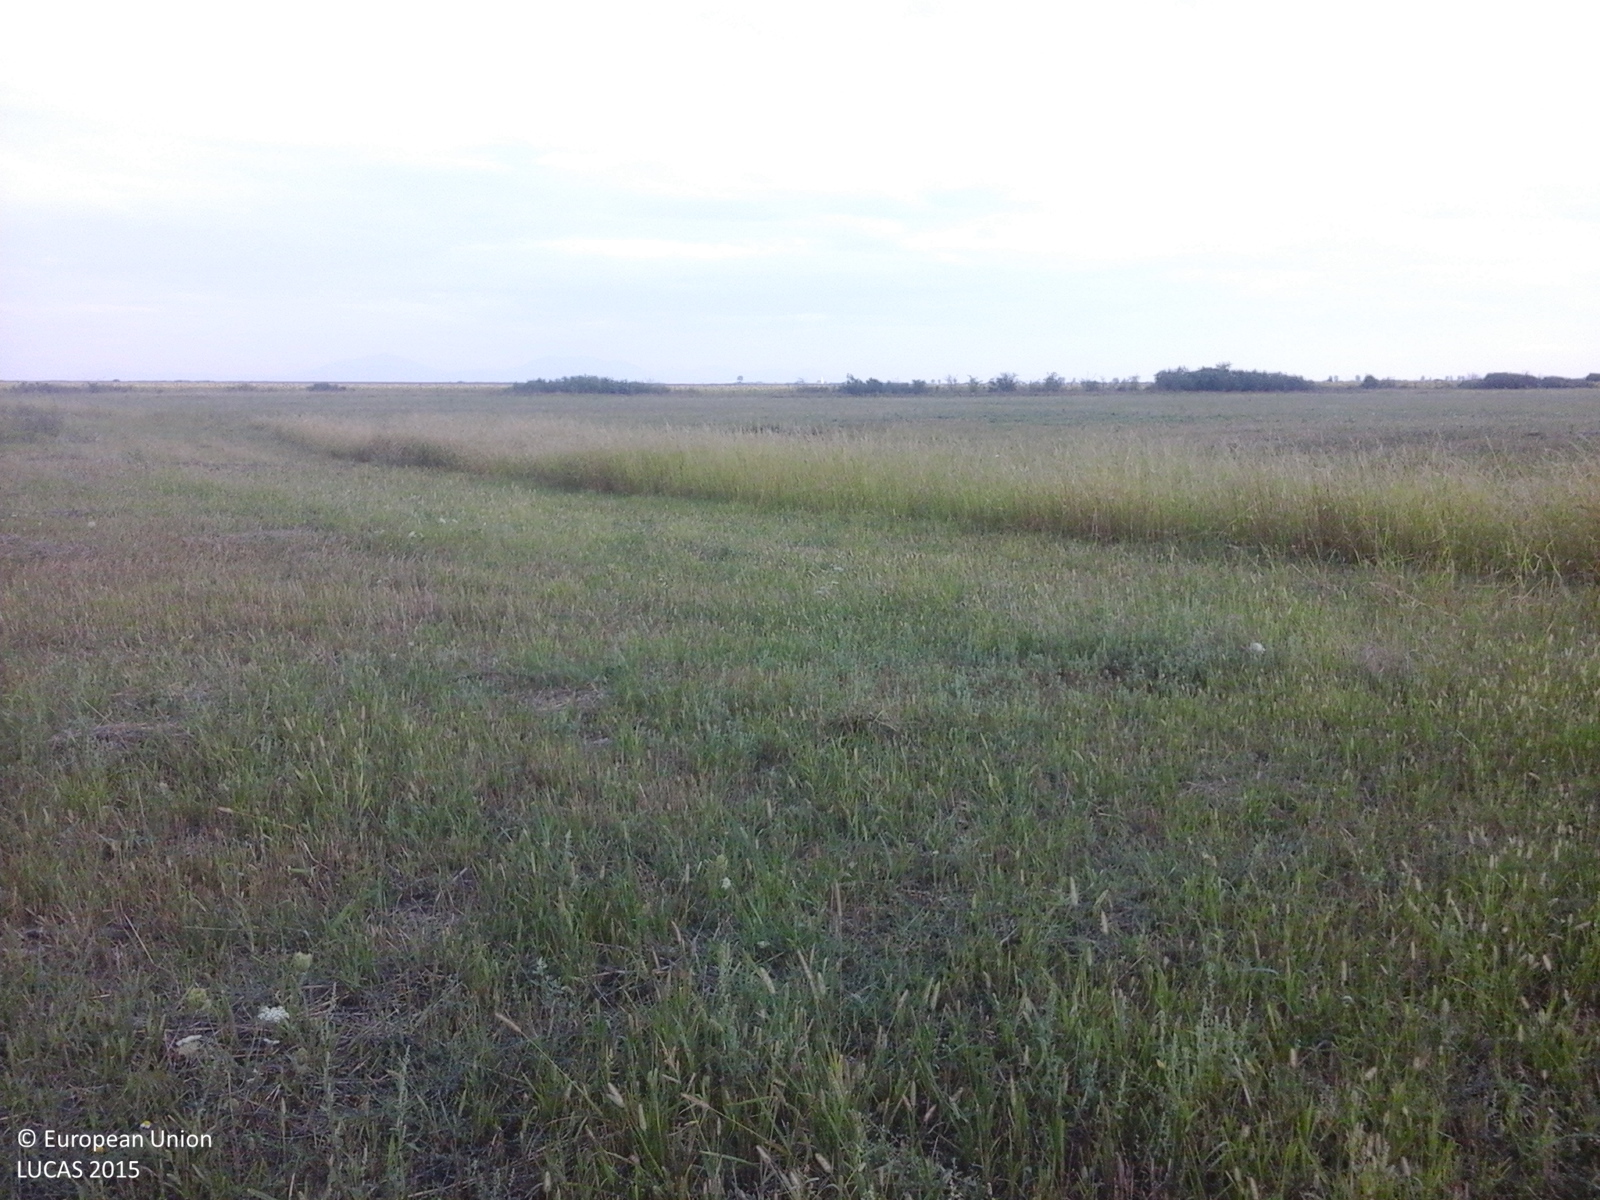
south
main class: Cropland
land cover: Common wheat
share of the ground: 50 - 75 %
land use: Agriculture (excluding fallow land and kitchen gardens)
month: August
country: RO
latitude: 45.3407
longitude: 21.2201
